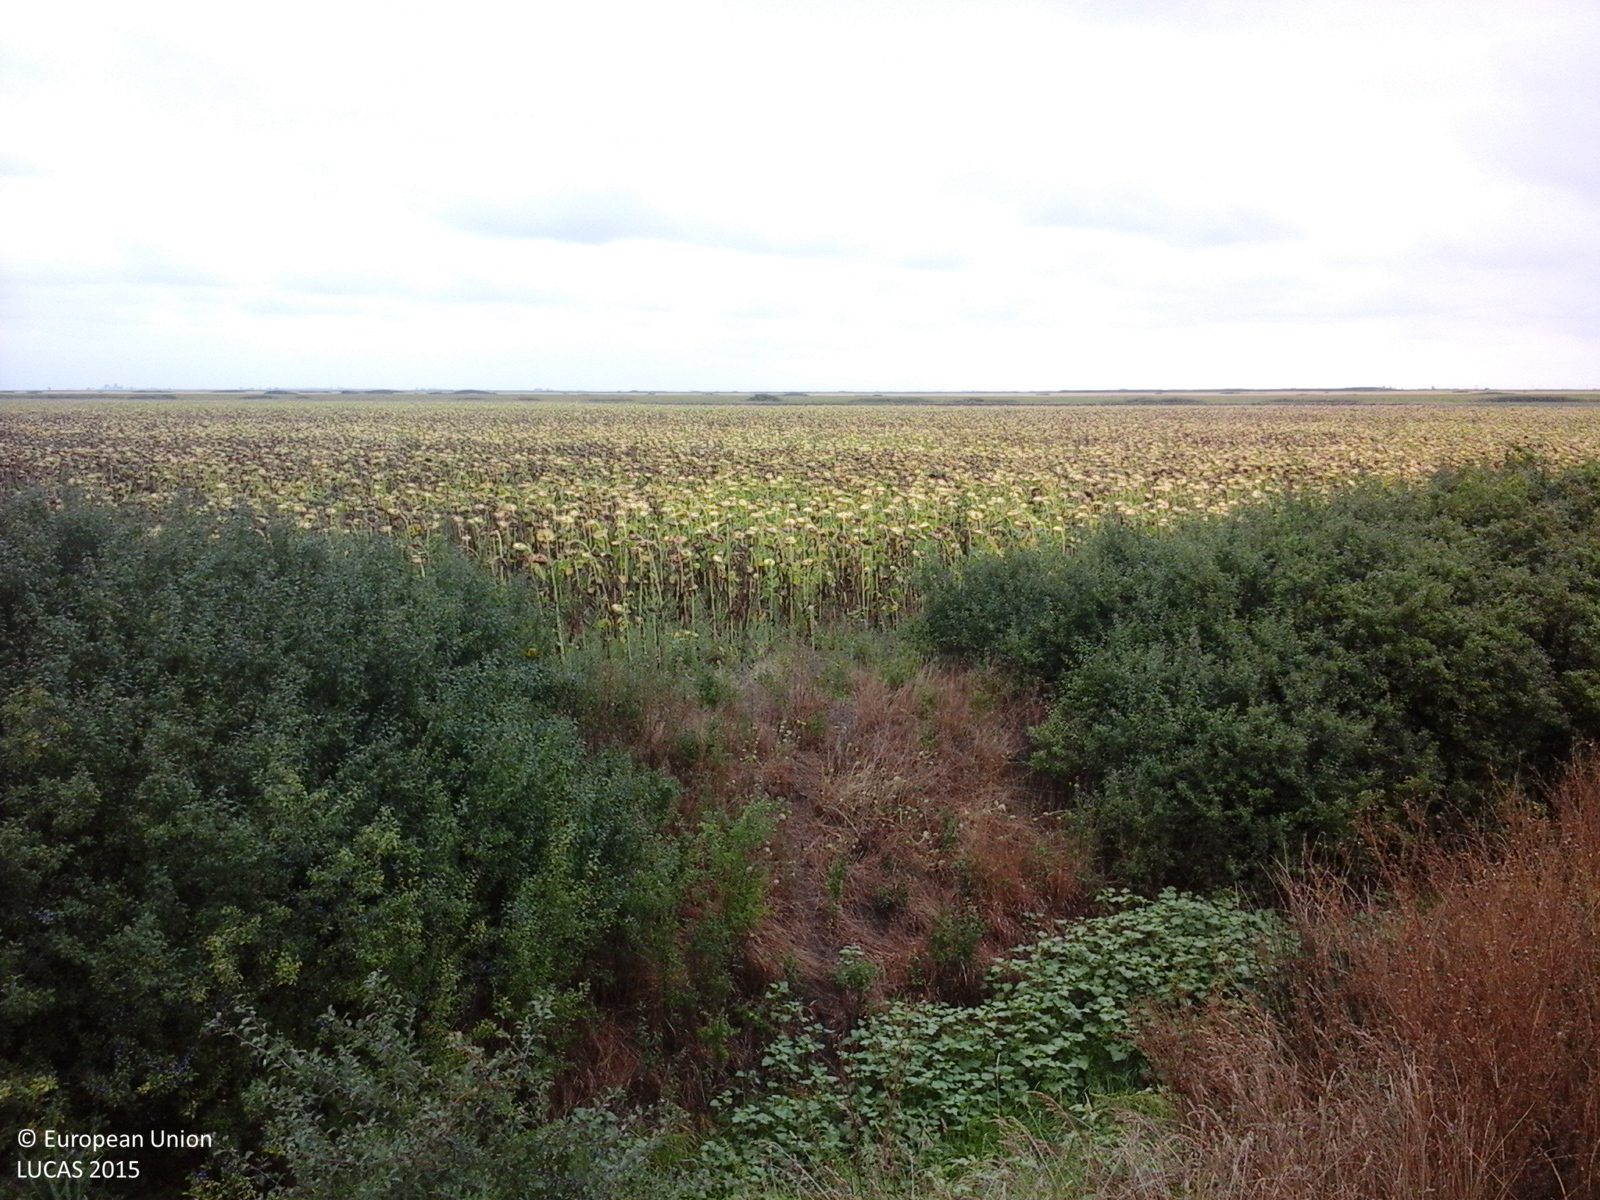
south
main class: Cropland
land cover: Sunflower
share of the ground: > 75 %
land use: Agriculture (excluding fallow land and kitchen gardens)
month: August
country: RO
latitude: 46.1241
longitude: 20.4942
